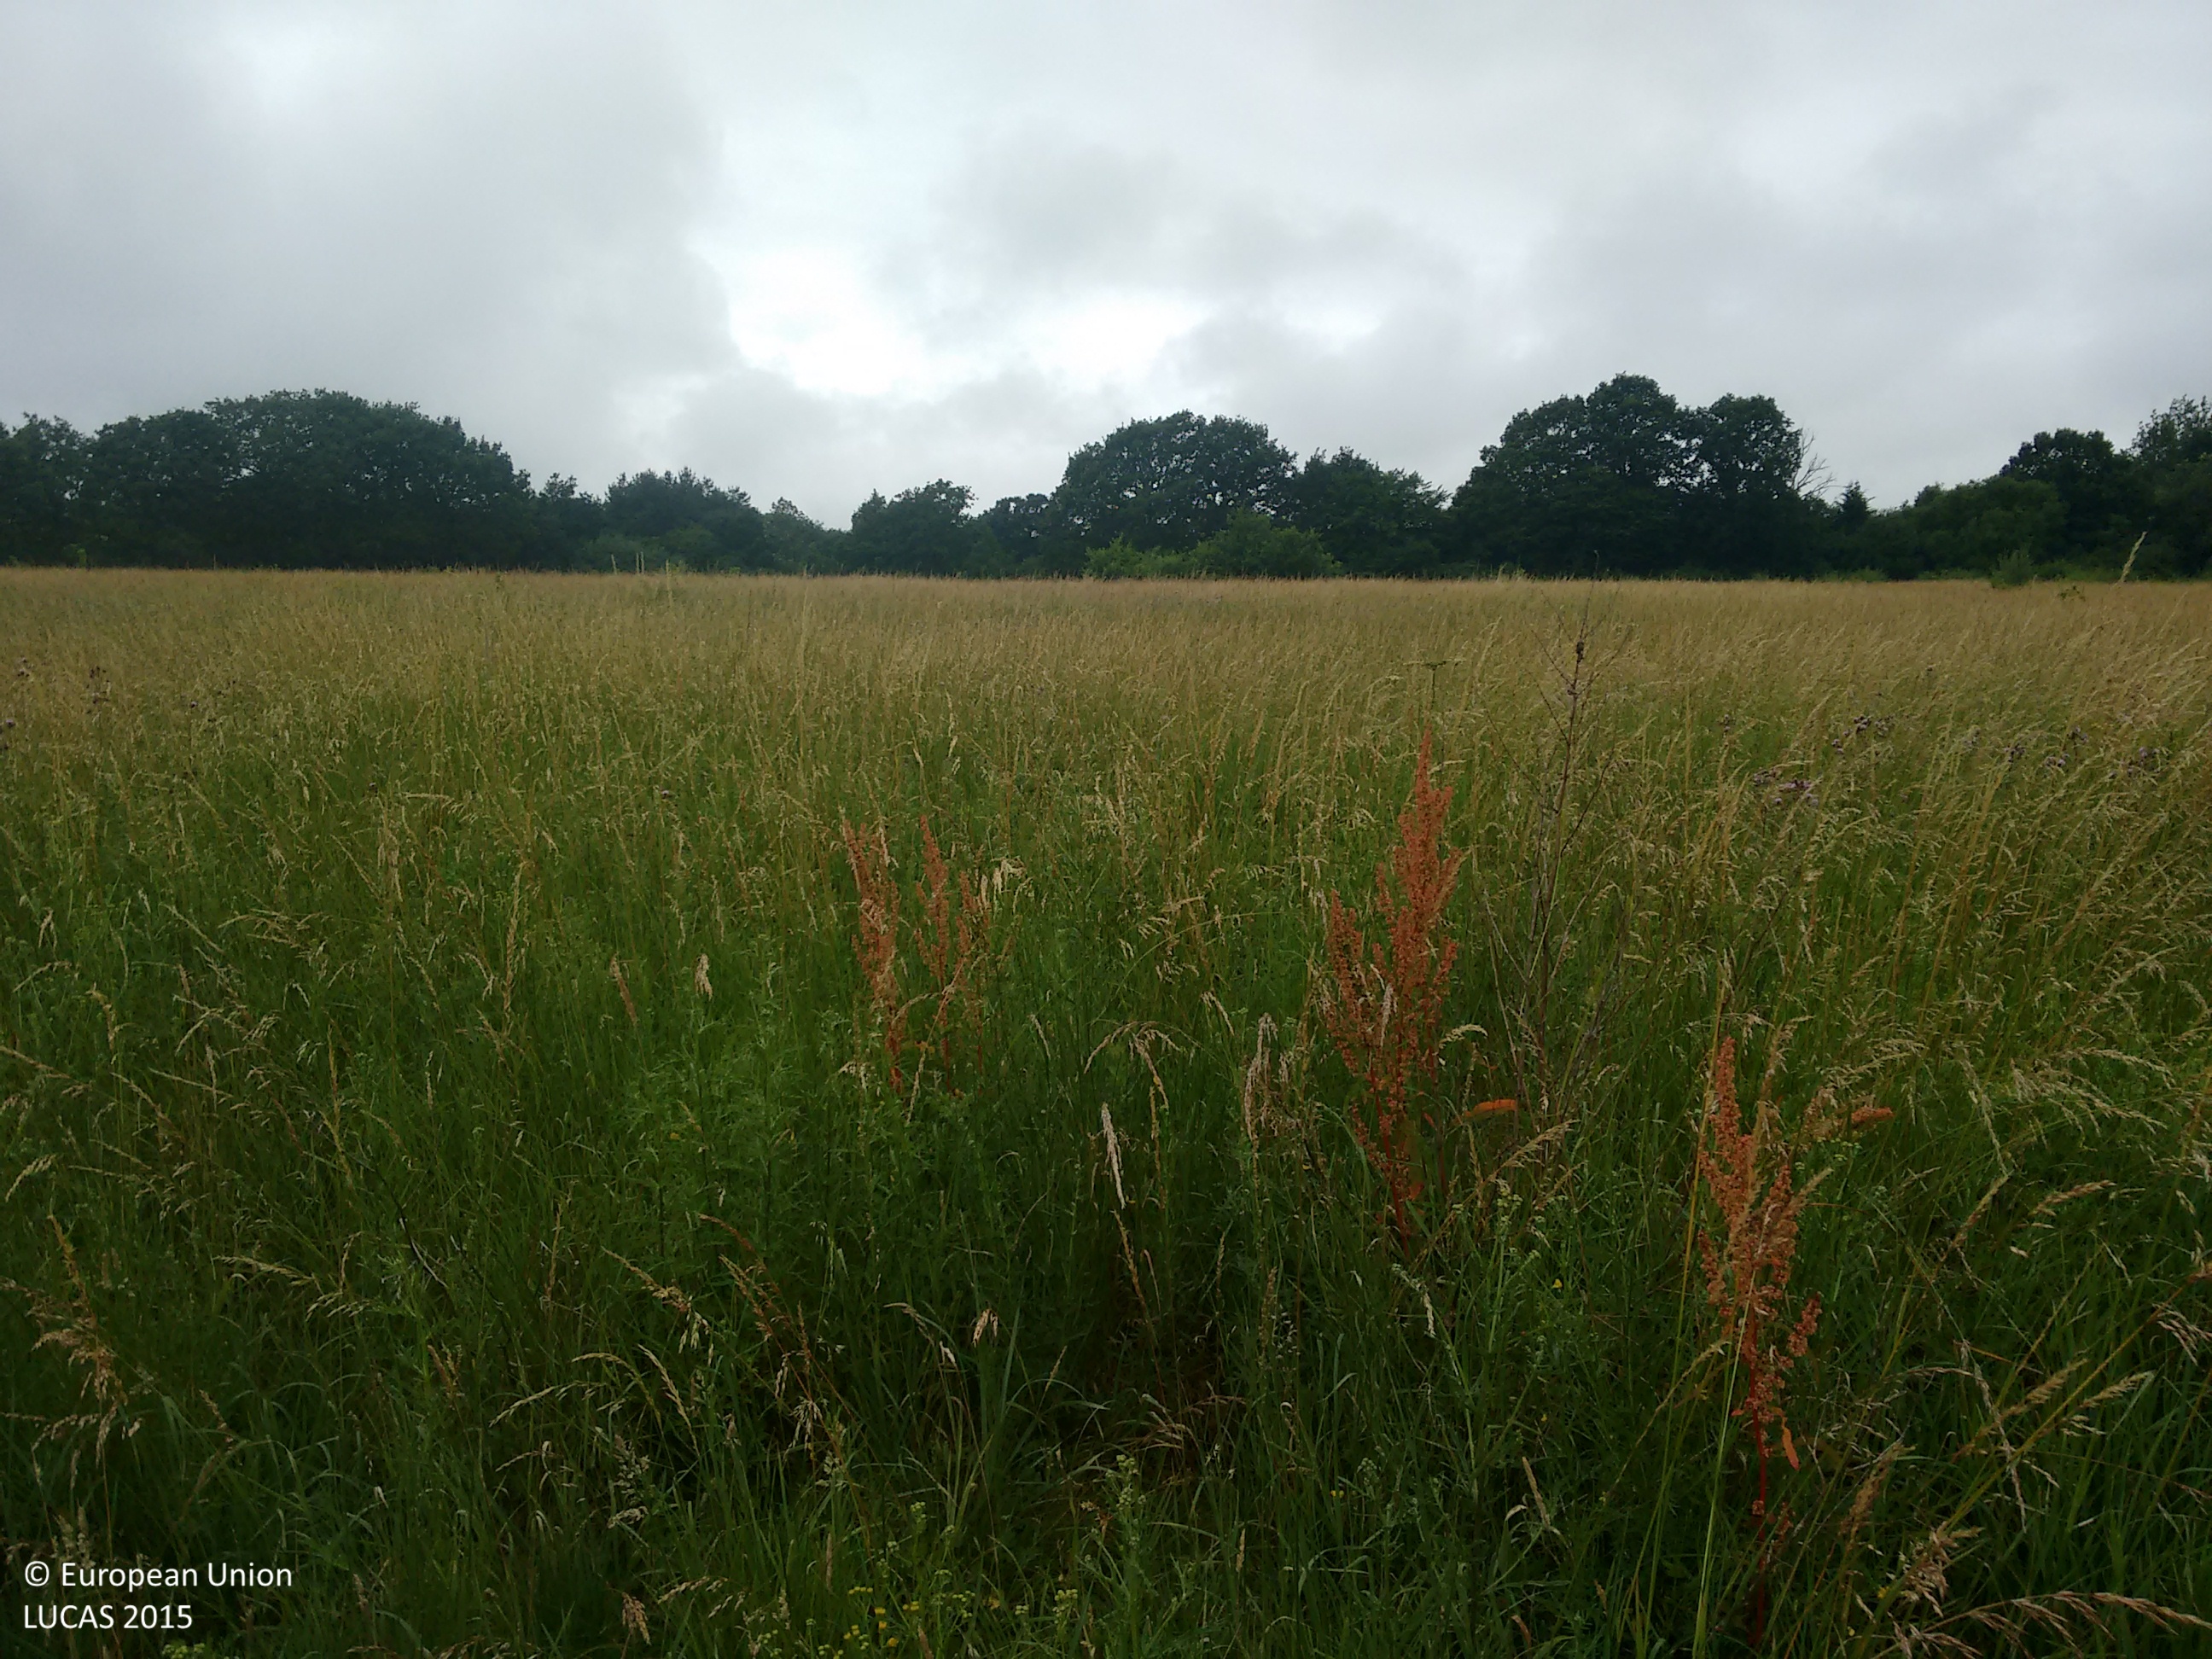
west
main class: Grassland
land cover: Grassland without tree/shrub cover
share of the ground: > 75 %
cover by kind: herbaceous plants 100 %
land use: Agriculture (excluding fallow land and kitchen gardens)
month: July
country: GB
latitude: 51.6474
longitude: 0.4476
